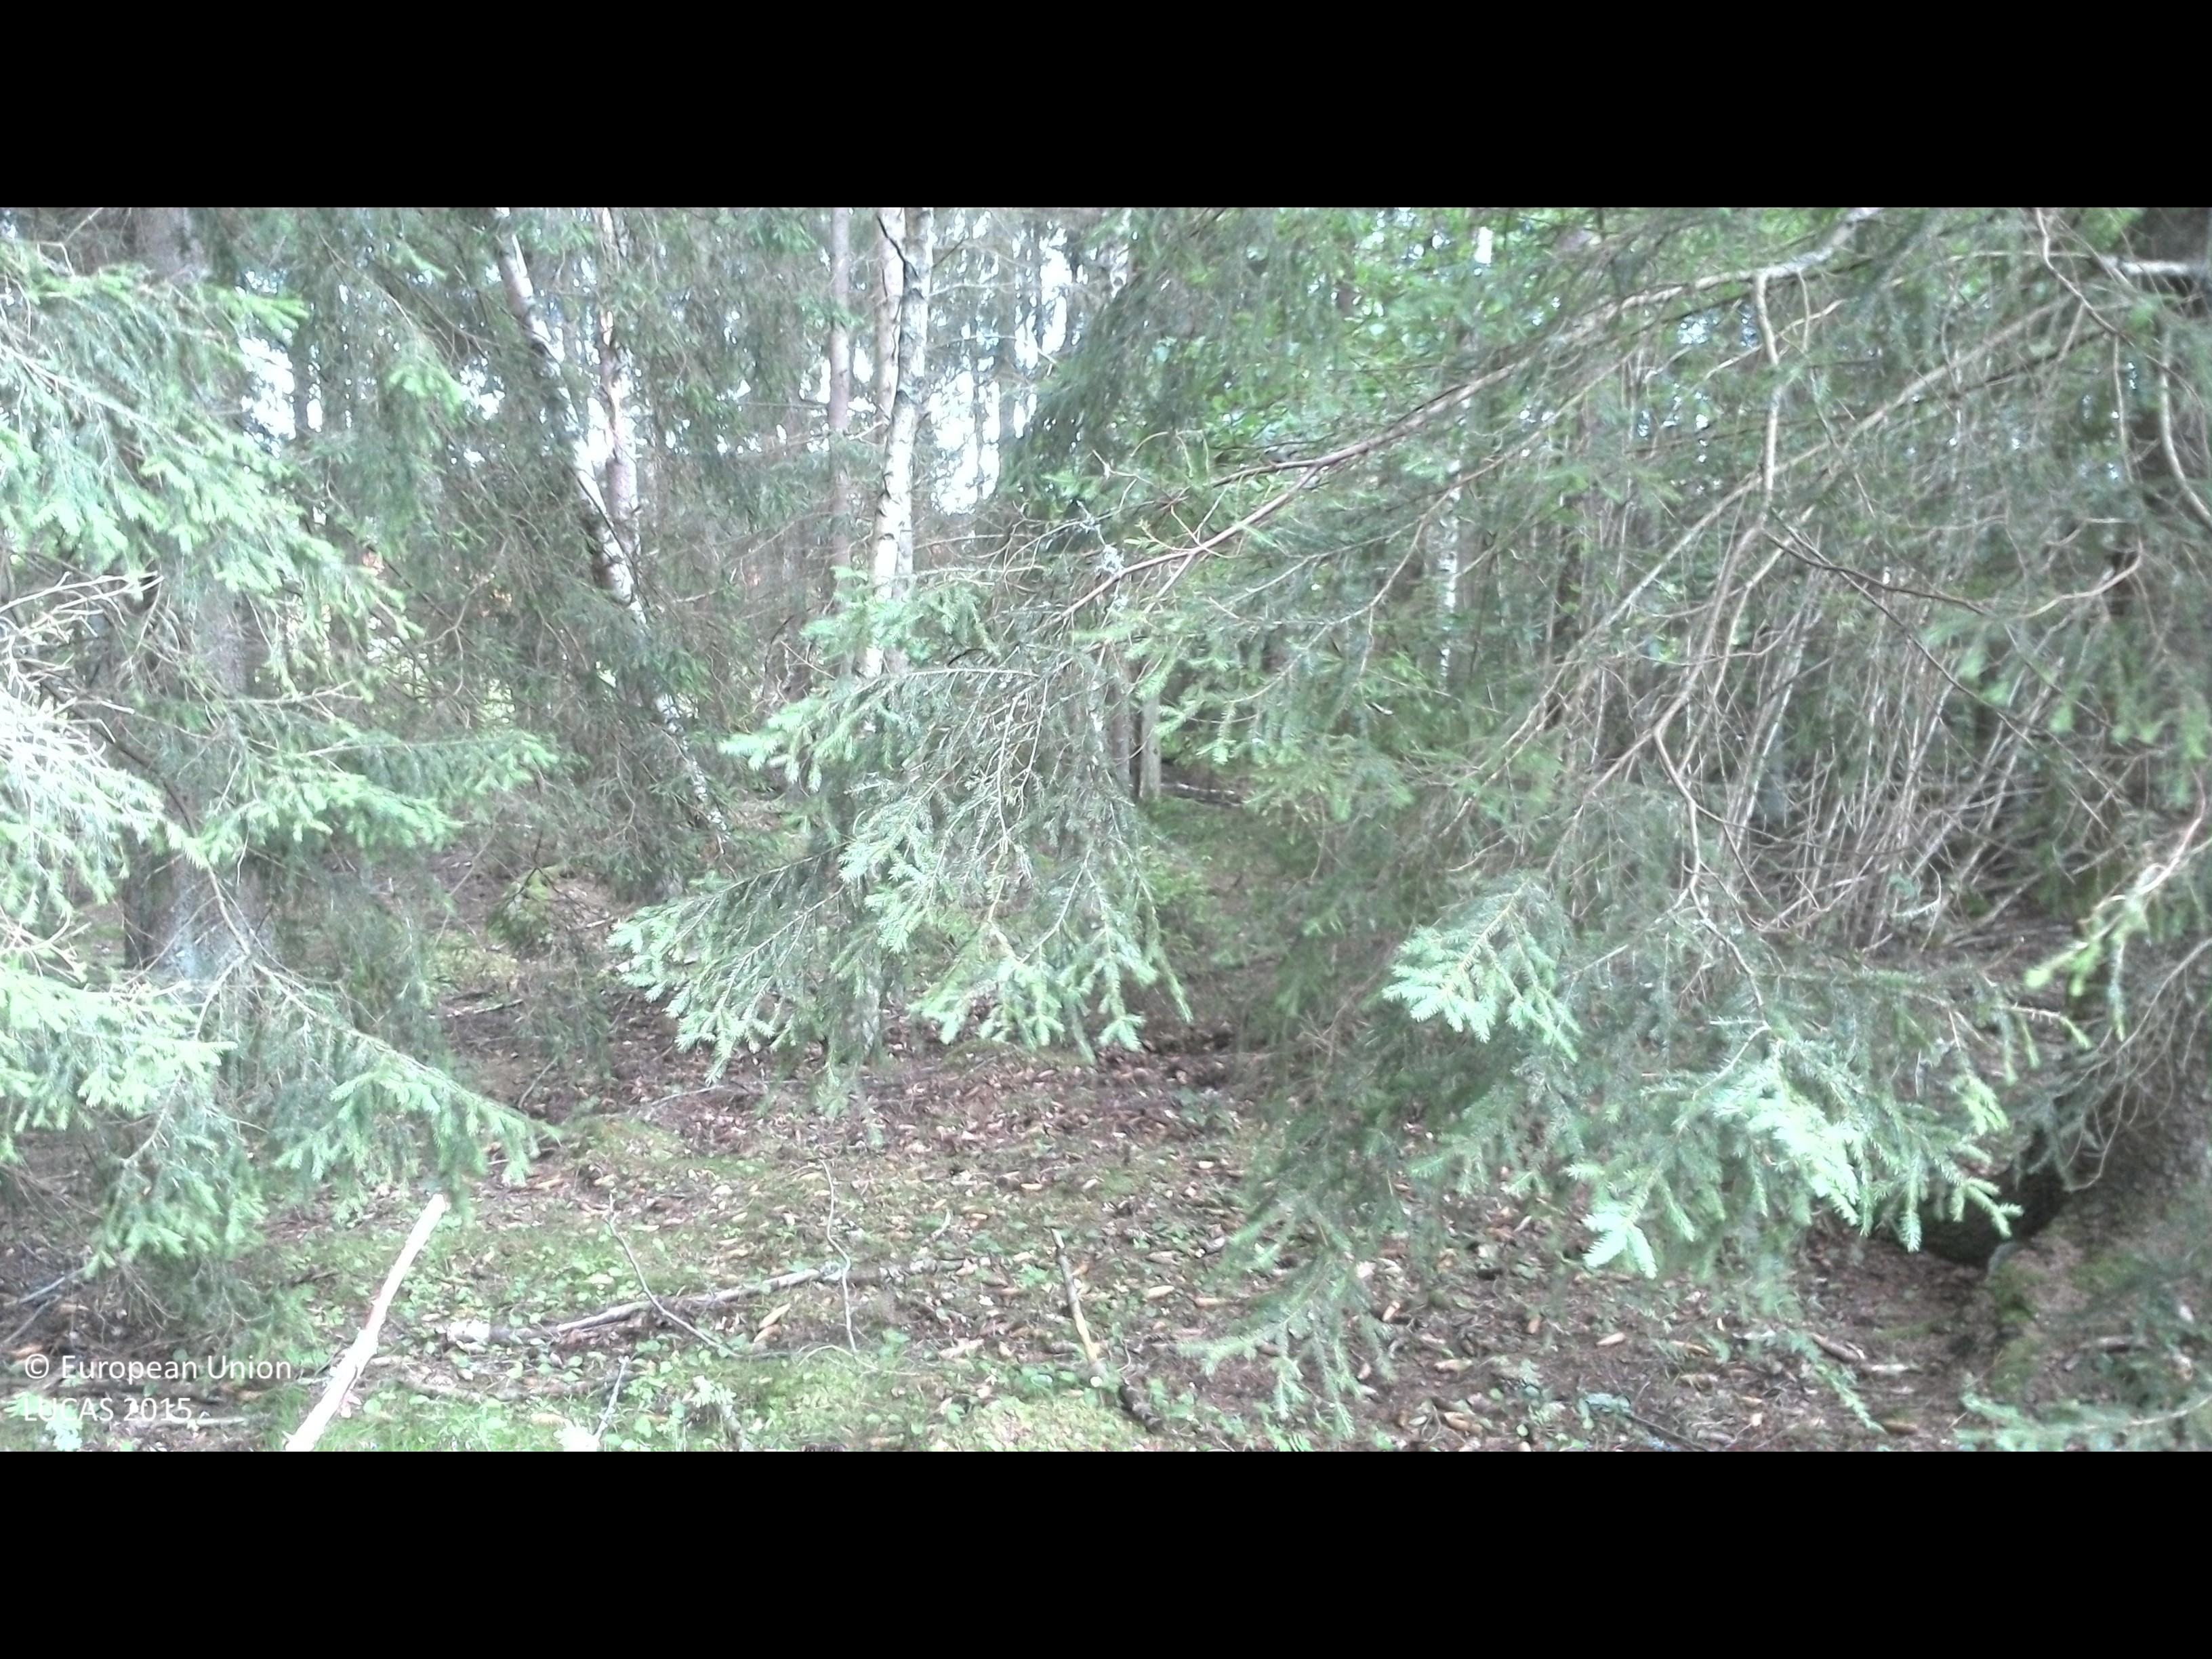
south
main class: Woodland
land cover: Spruce dominated mixed woodland
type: boreal forest
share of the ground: > 75 %
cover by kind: coniferous forest trees 55 %, broadleaved forest trees 20 %, shrubs 15 %, herbaceous plants 10 %
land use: Forestry
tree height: > 5 m
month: July
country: SE
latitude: 56.4600
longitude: 14.7527
